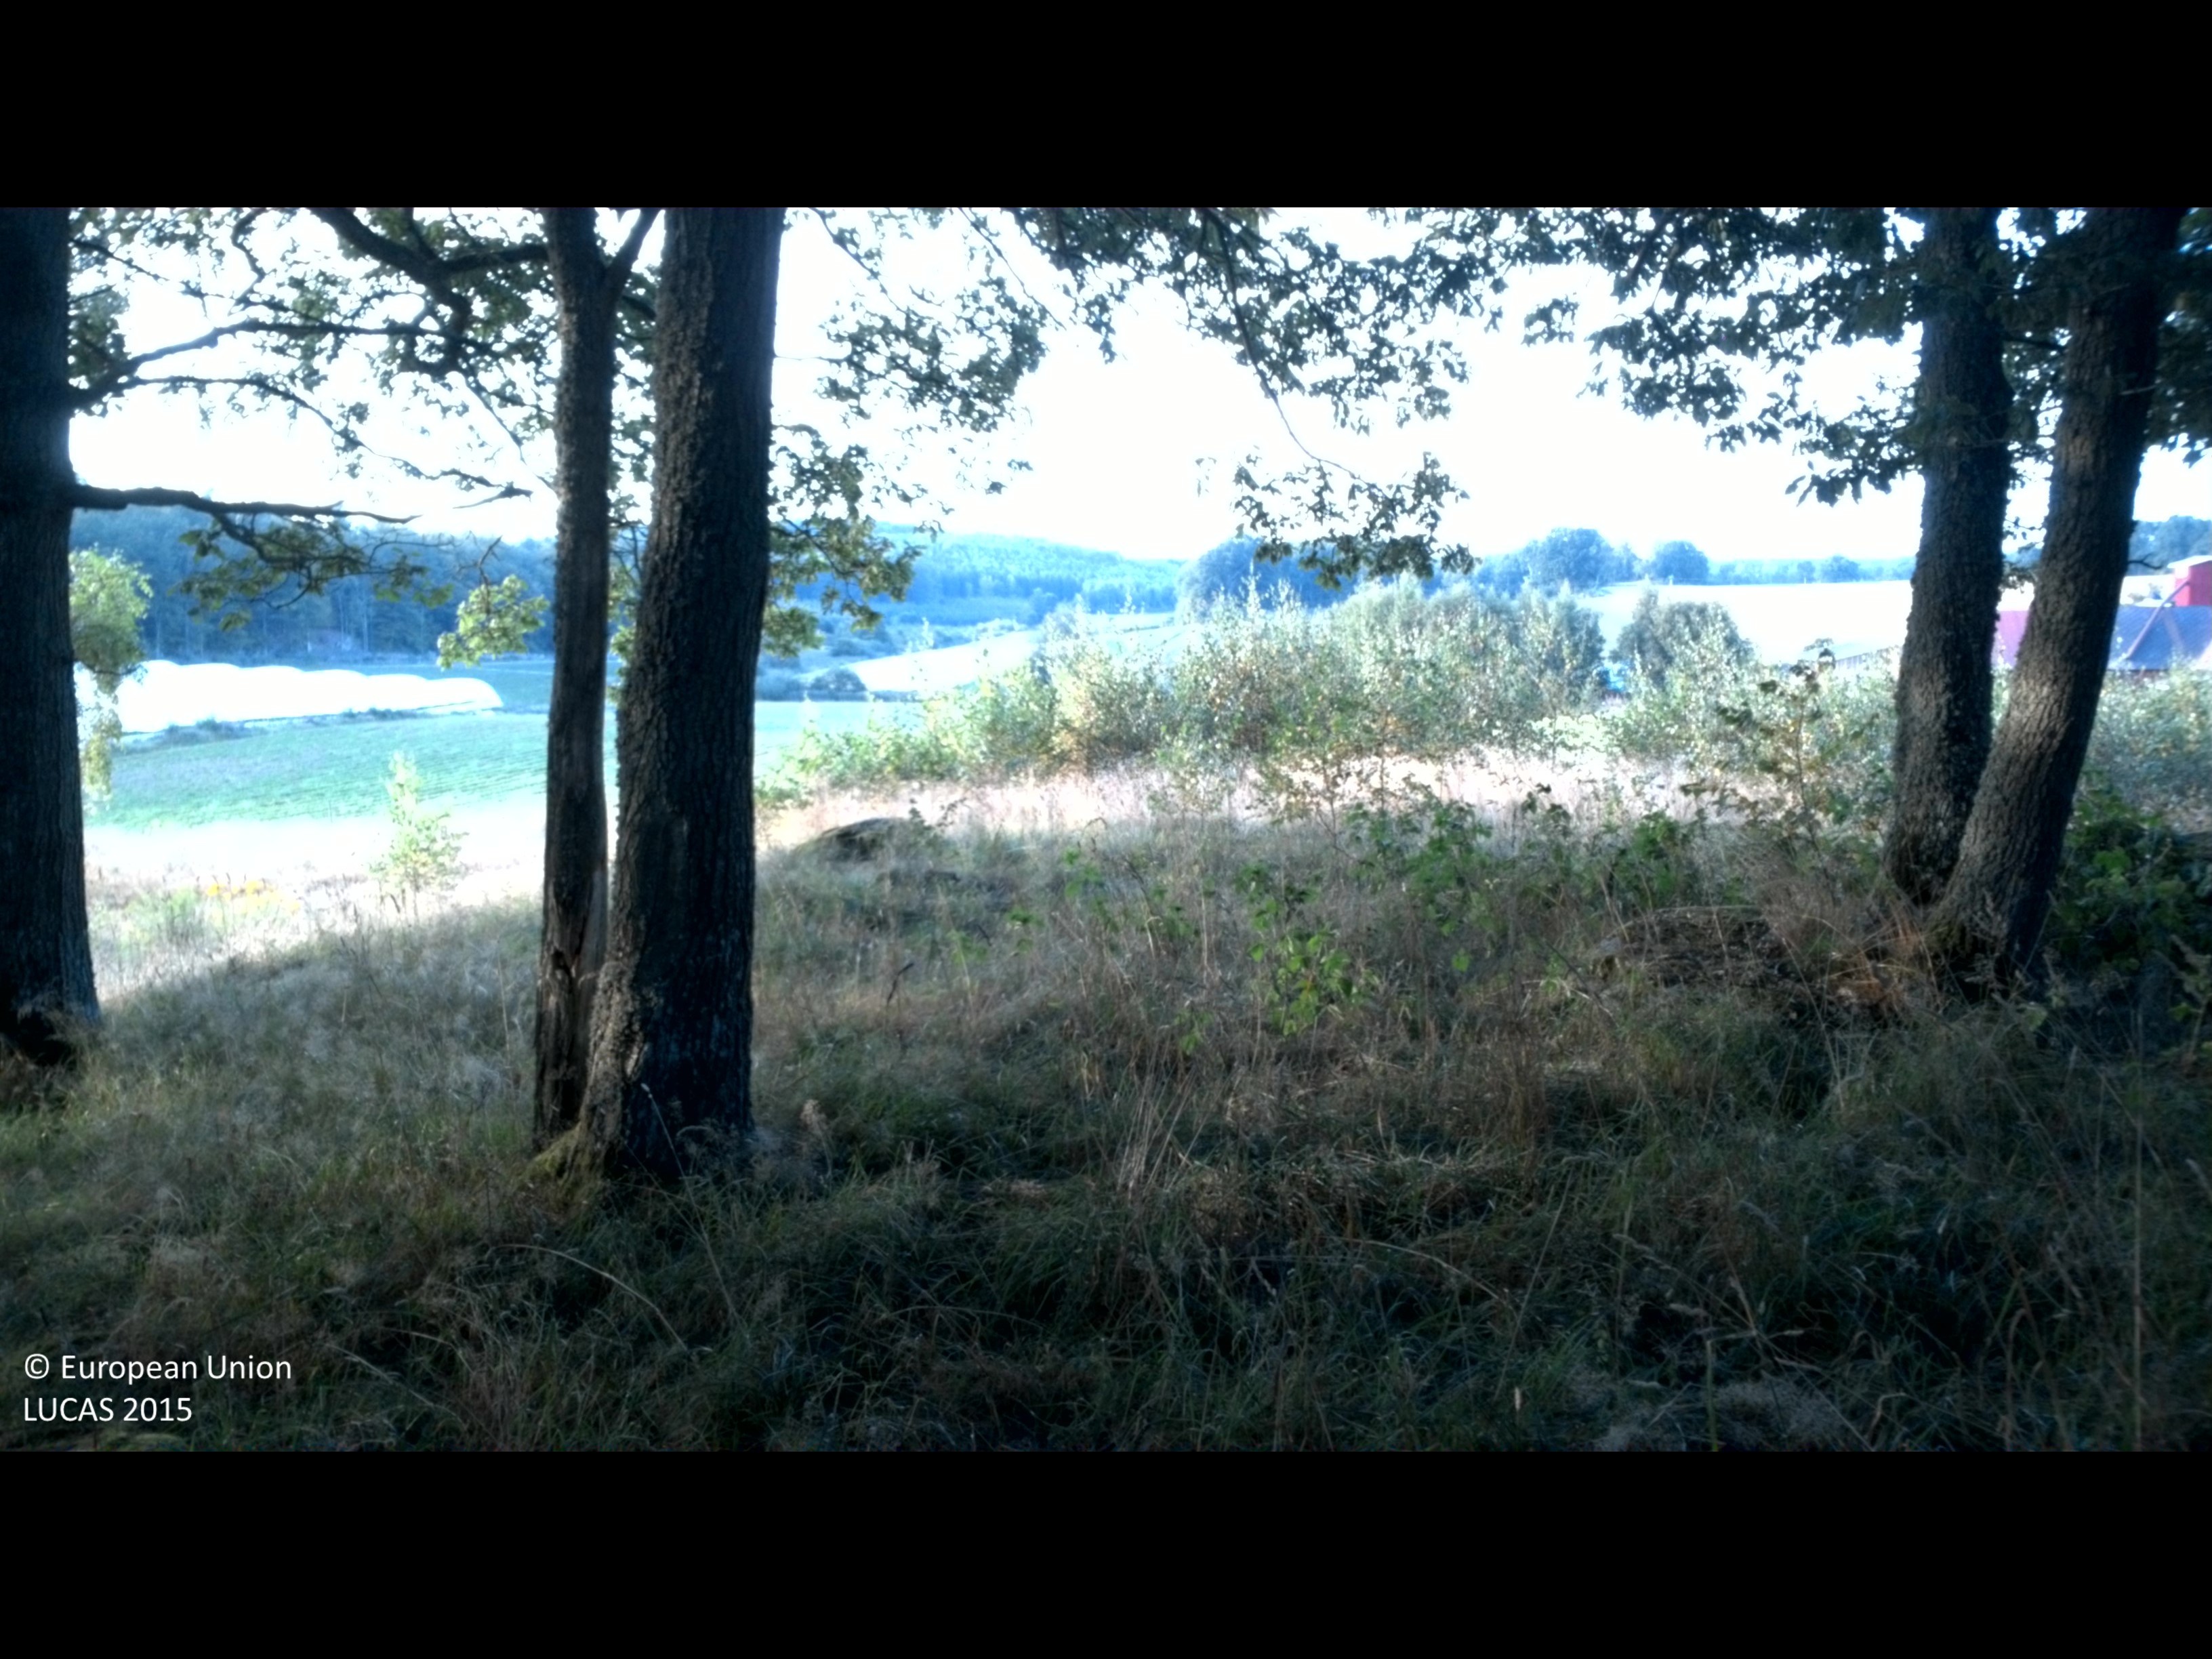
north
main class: Woodland
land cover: Broadleaved woodland
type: mesophytic deciduous forest
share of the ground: 25 - 50 %
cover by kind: herbaceous plants 50 %, broadleaved forest trees 40 %, shrubs 10 %
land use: Forestry
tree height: > 5 m
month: August
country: SE
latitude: 56.2316
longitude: 14.5955
